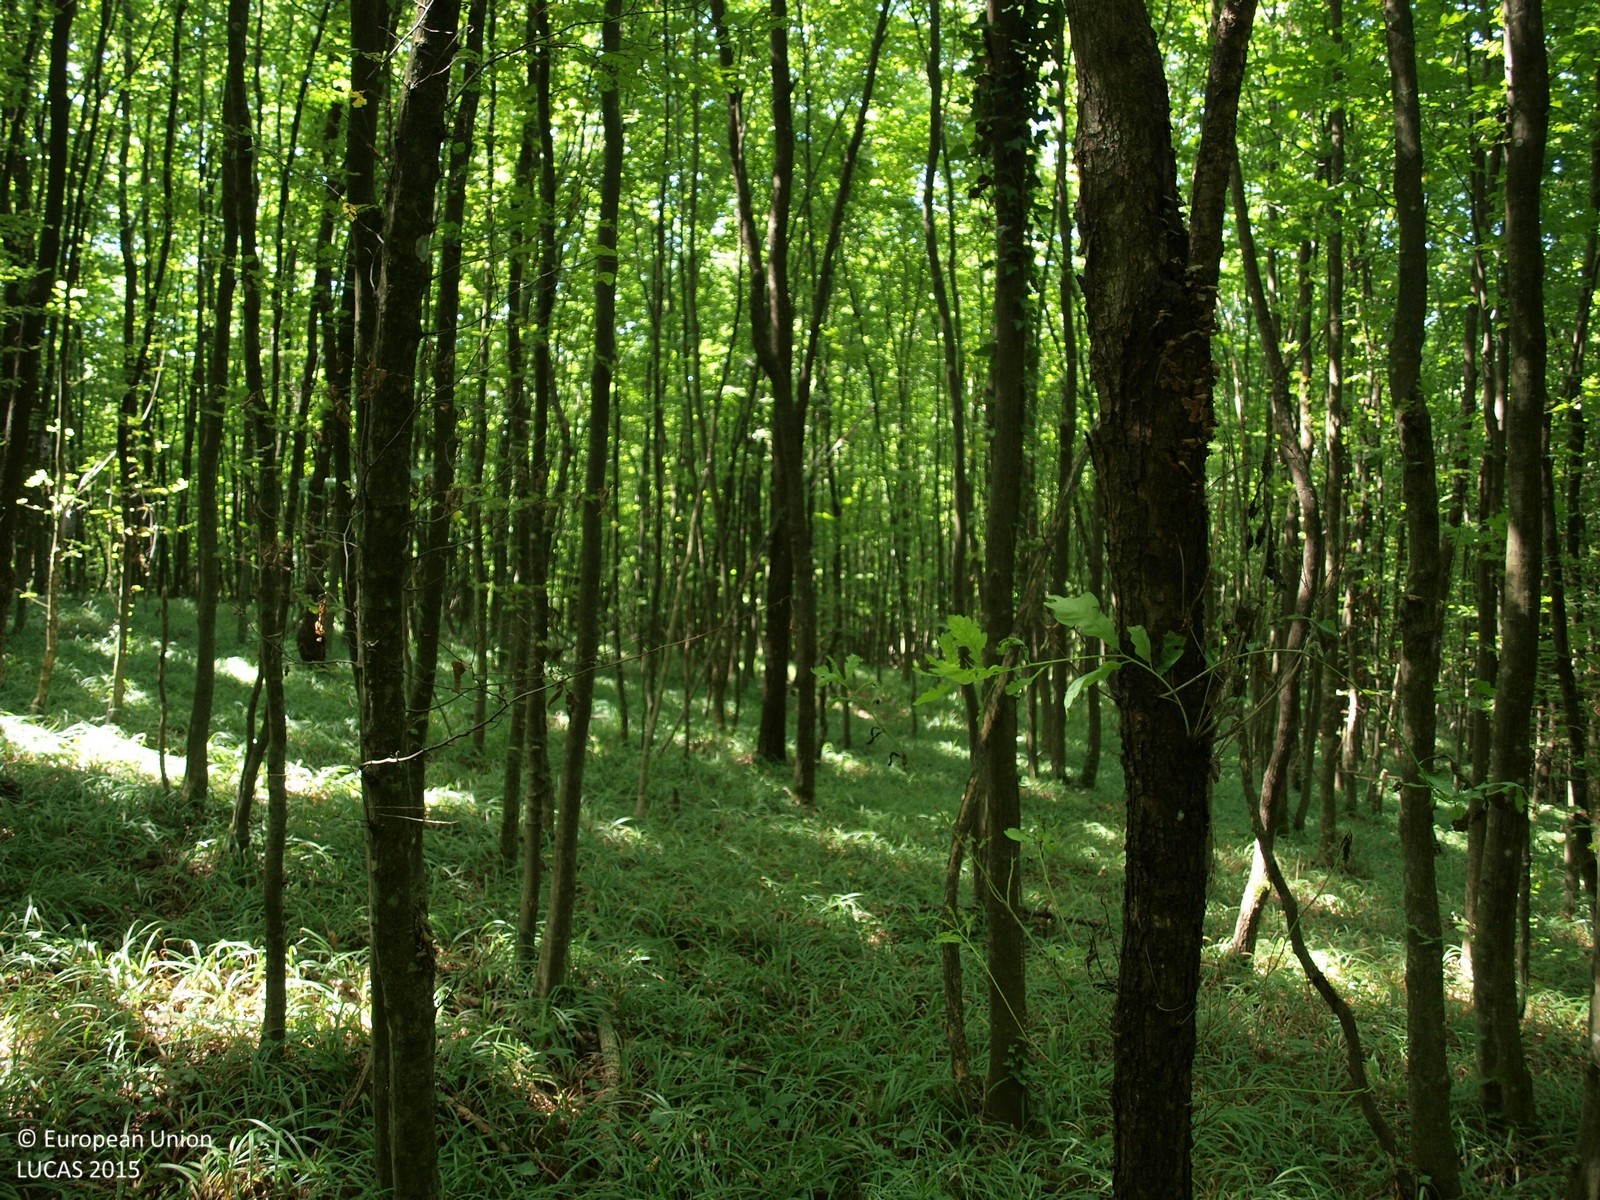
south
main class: Woodland
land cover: Broadleaved woodland
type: mesophytic deciduous forest
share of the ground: > 75 %
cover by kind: broadleaved forest trees 100 %
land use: Forestry
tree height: > 5 m
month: August
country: HR
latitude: 46.0154
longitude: 16.3929
